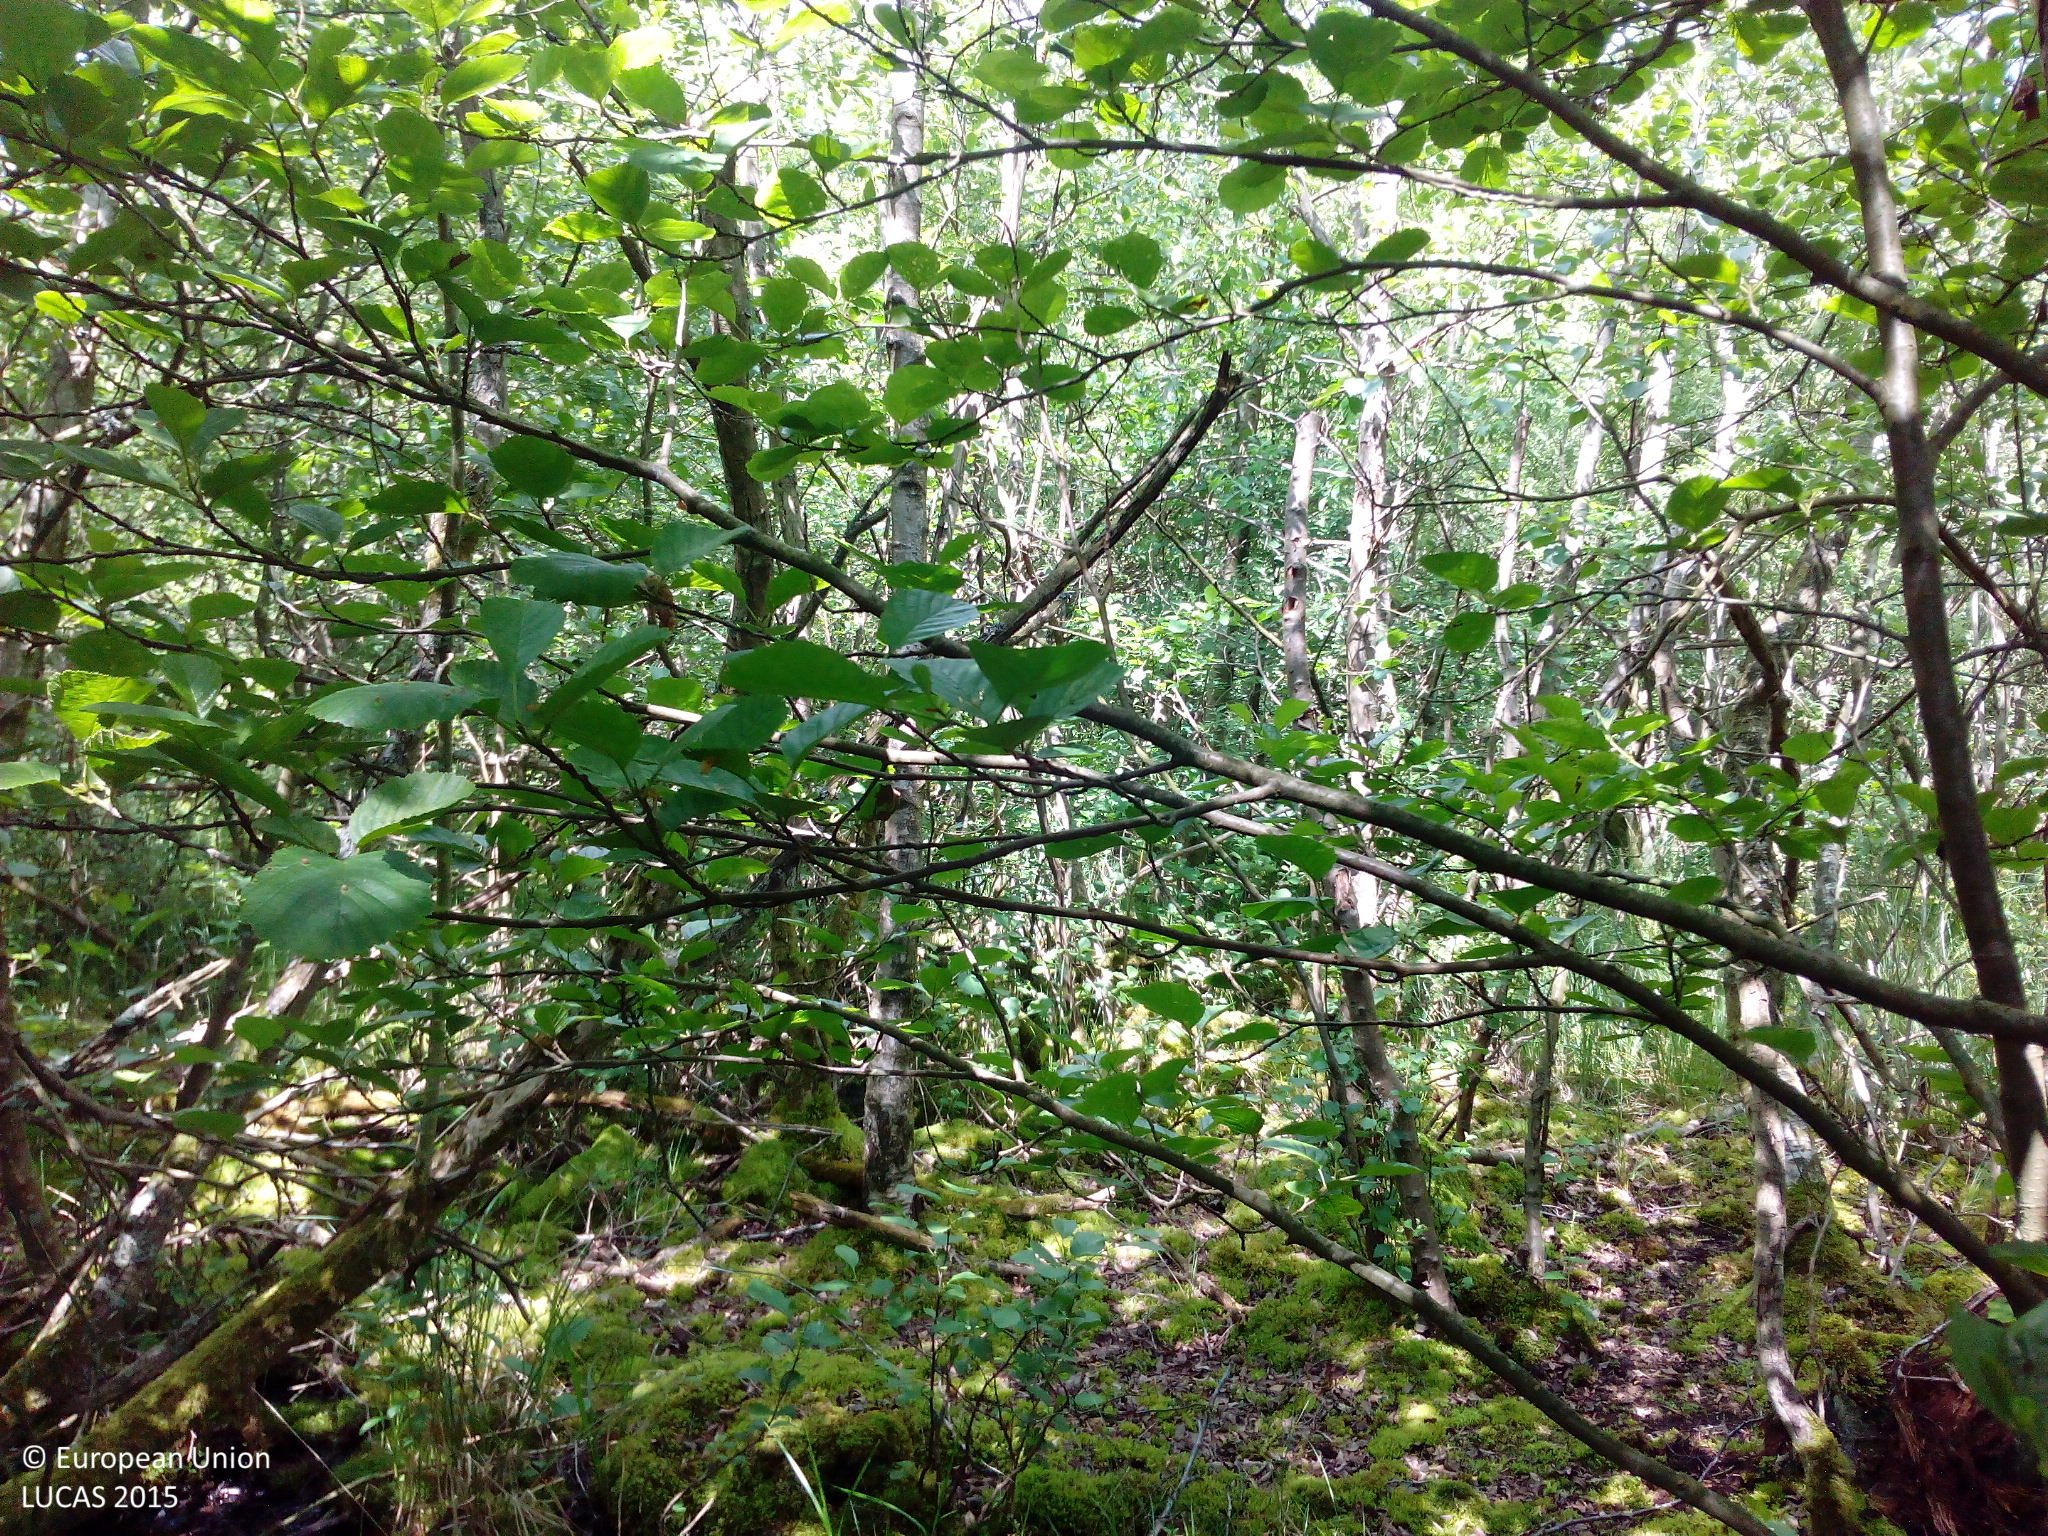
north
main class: Woodland
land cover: Broadleaved woodland
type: mesophytic deciduous forest
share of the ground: 50 - 75 %
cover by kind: broadleaved forest trees 70 %, herbaceous plants 15 %, lichens and mosses 10 %, shrubs 5 %
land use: Semi-natural and natural areas not in use
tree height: > 5 m
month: June
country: DK
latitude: 56.2579
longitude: 10.6610
